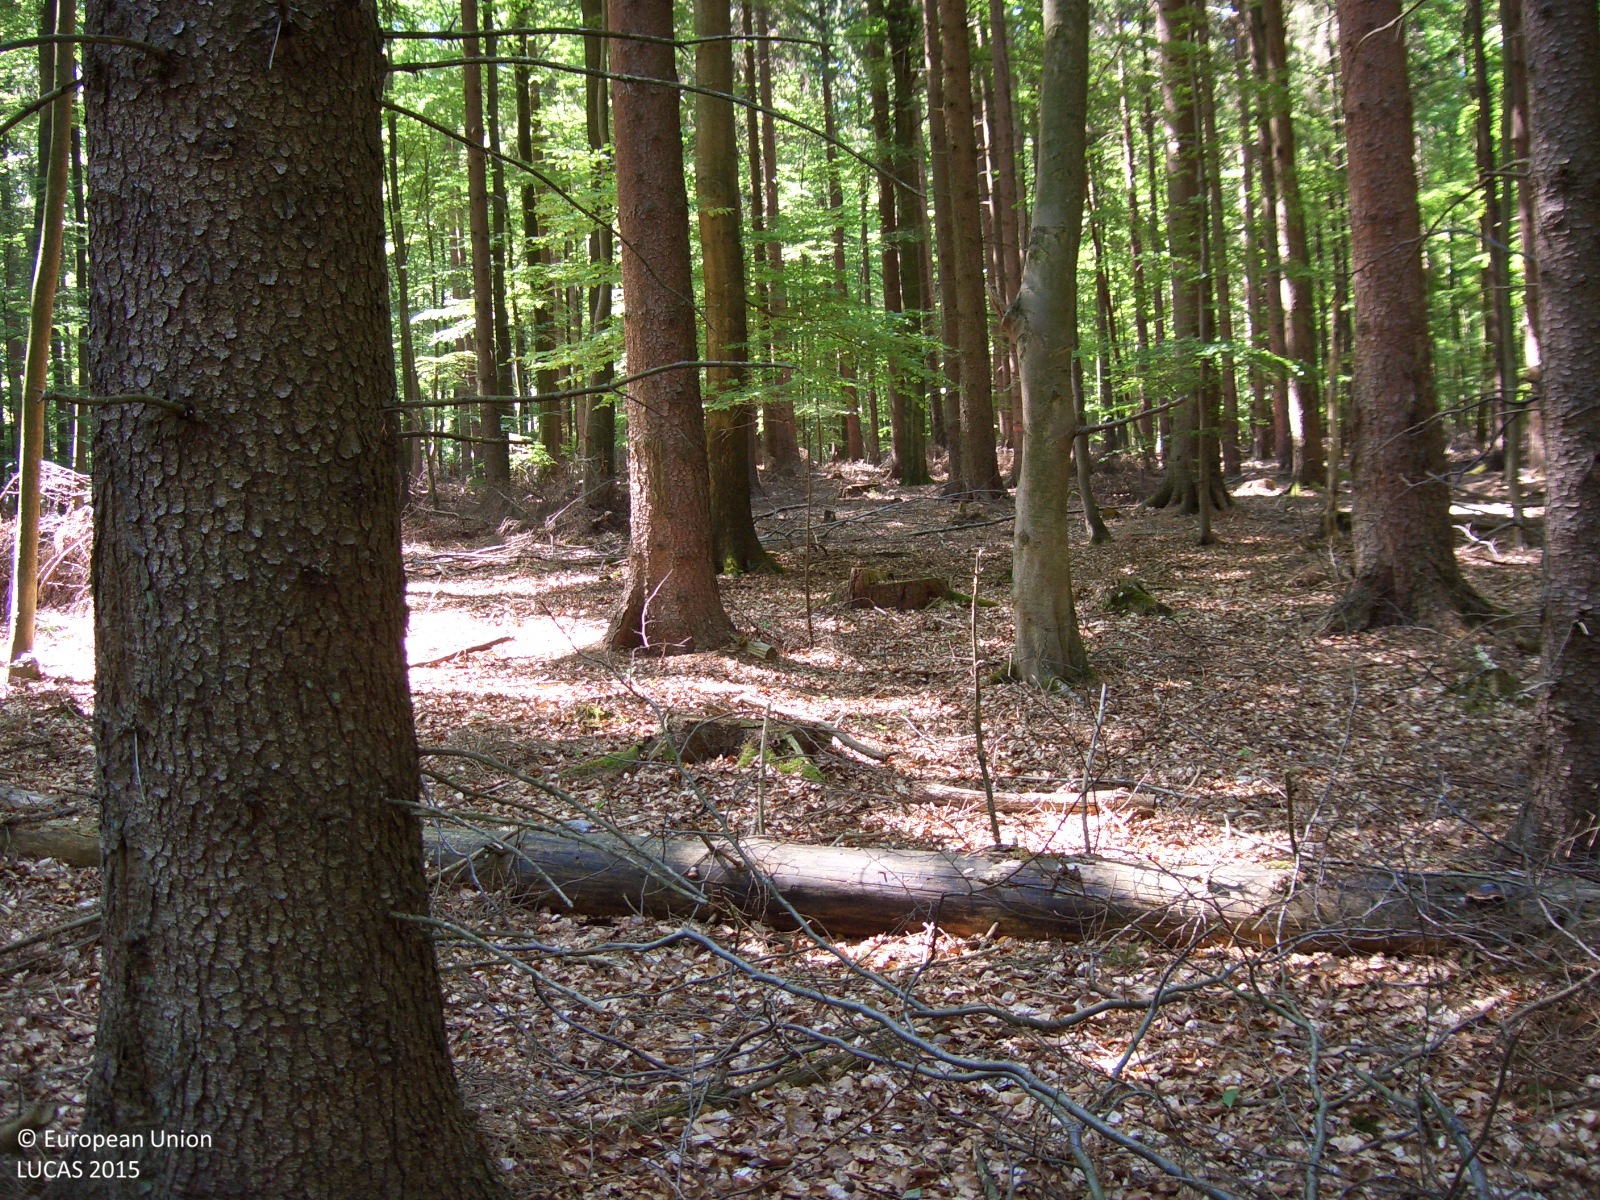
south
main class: Woodland
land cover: Spruce dominated mixed woodland
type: beech forest
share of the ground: > 75 %
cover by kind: broadleaved forest trees 70 %, coniferous forest trees 30 %
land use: Forestry
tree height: > 5 m
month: June
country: DE
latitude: 50.6985
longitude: 6.2475
